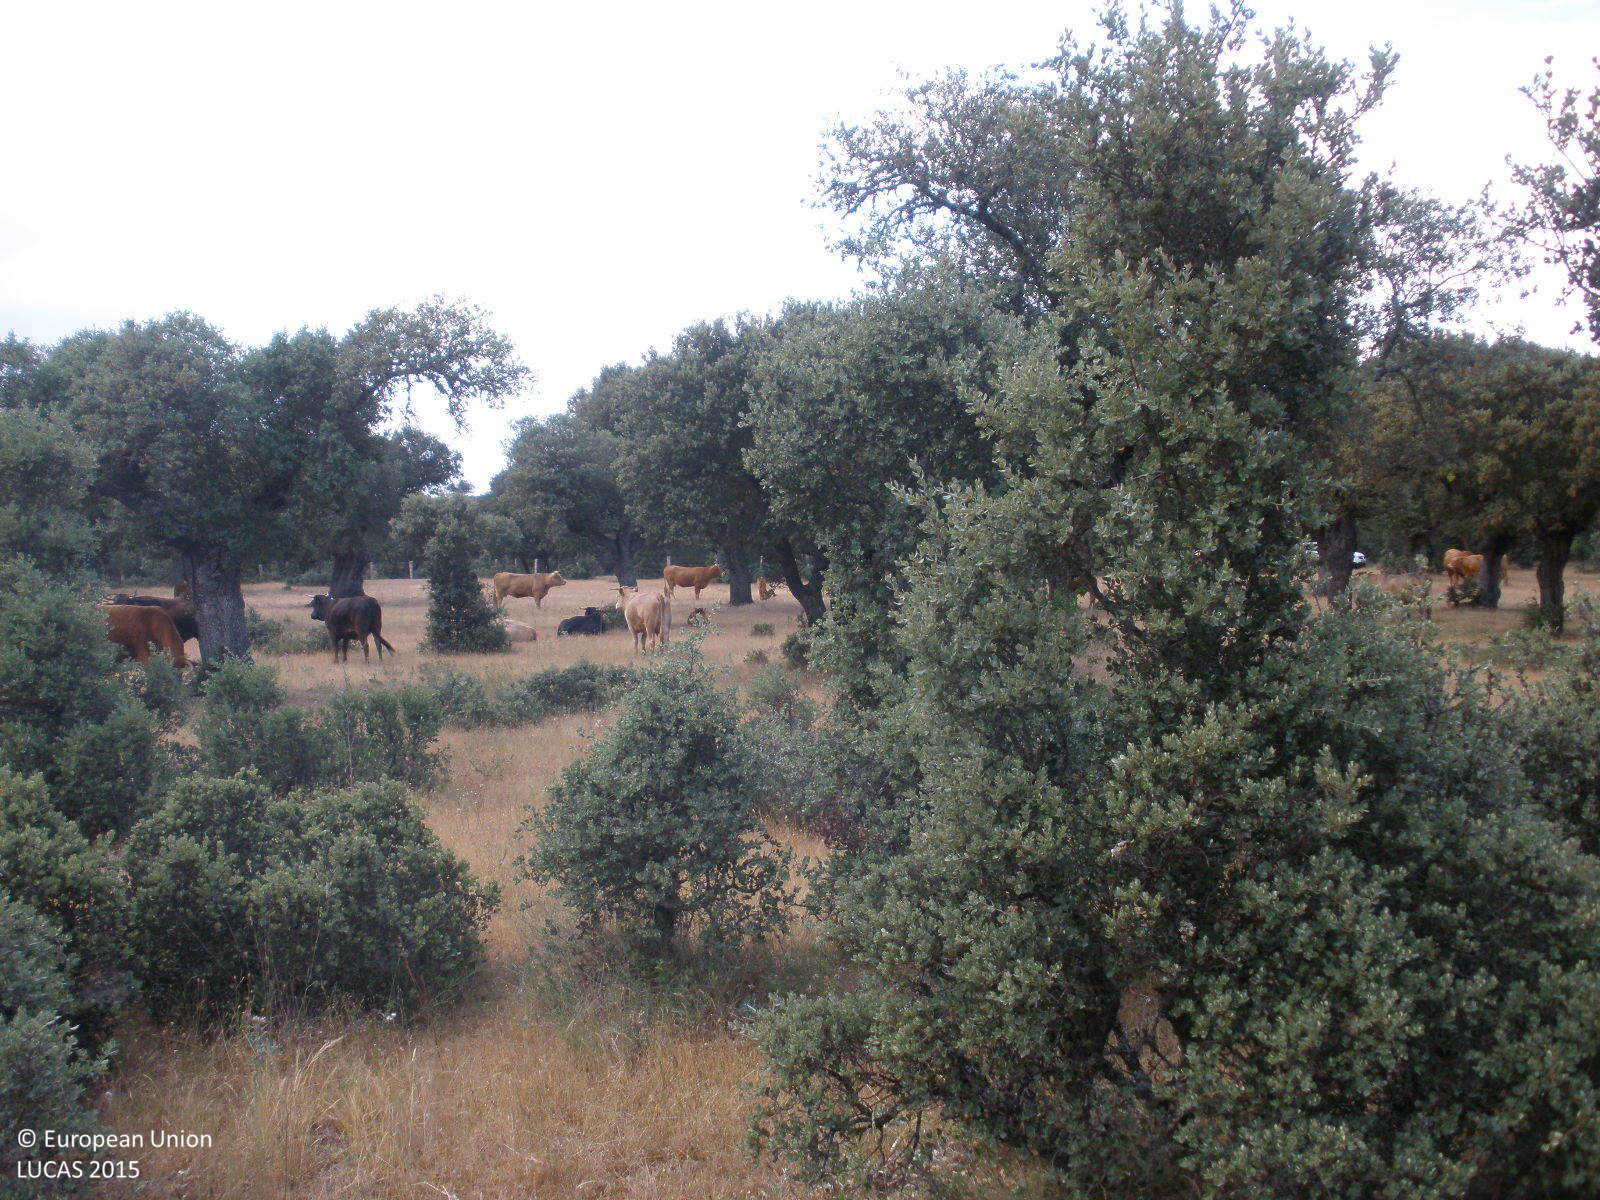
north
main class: Woodland
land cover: Broadleaved woodland
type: broadleaved evergreen forest
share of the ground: > 75 %
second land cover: Grassland without tree/shrub cover
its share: > 75 %
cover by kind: broadleaved forest trees 60 %, herbaceous plants 30 %, shrubs 10 %
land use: Forestry
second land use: Agriculture (excluding fallow land and kitchen gardens)
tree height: < 5 m
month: June
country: ES
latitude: 40.7251
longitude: -6.2464
